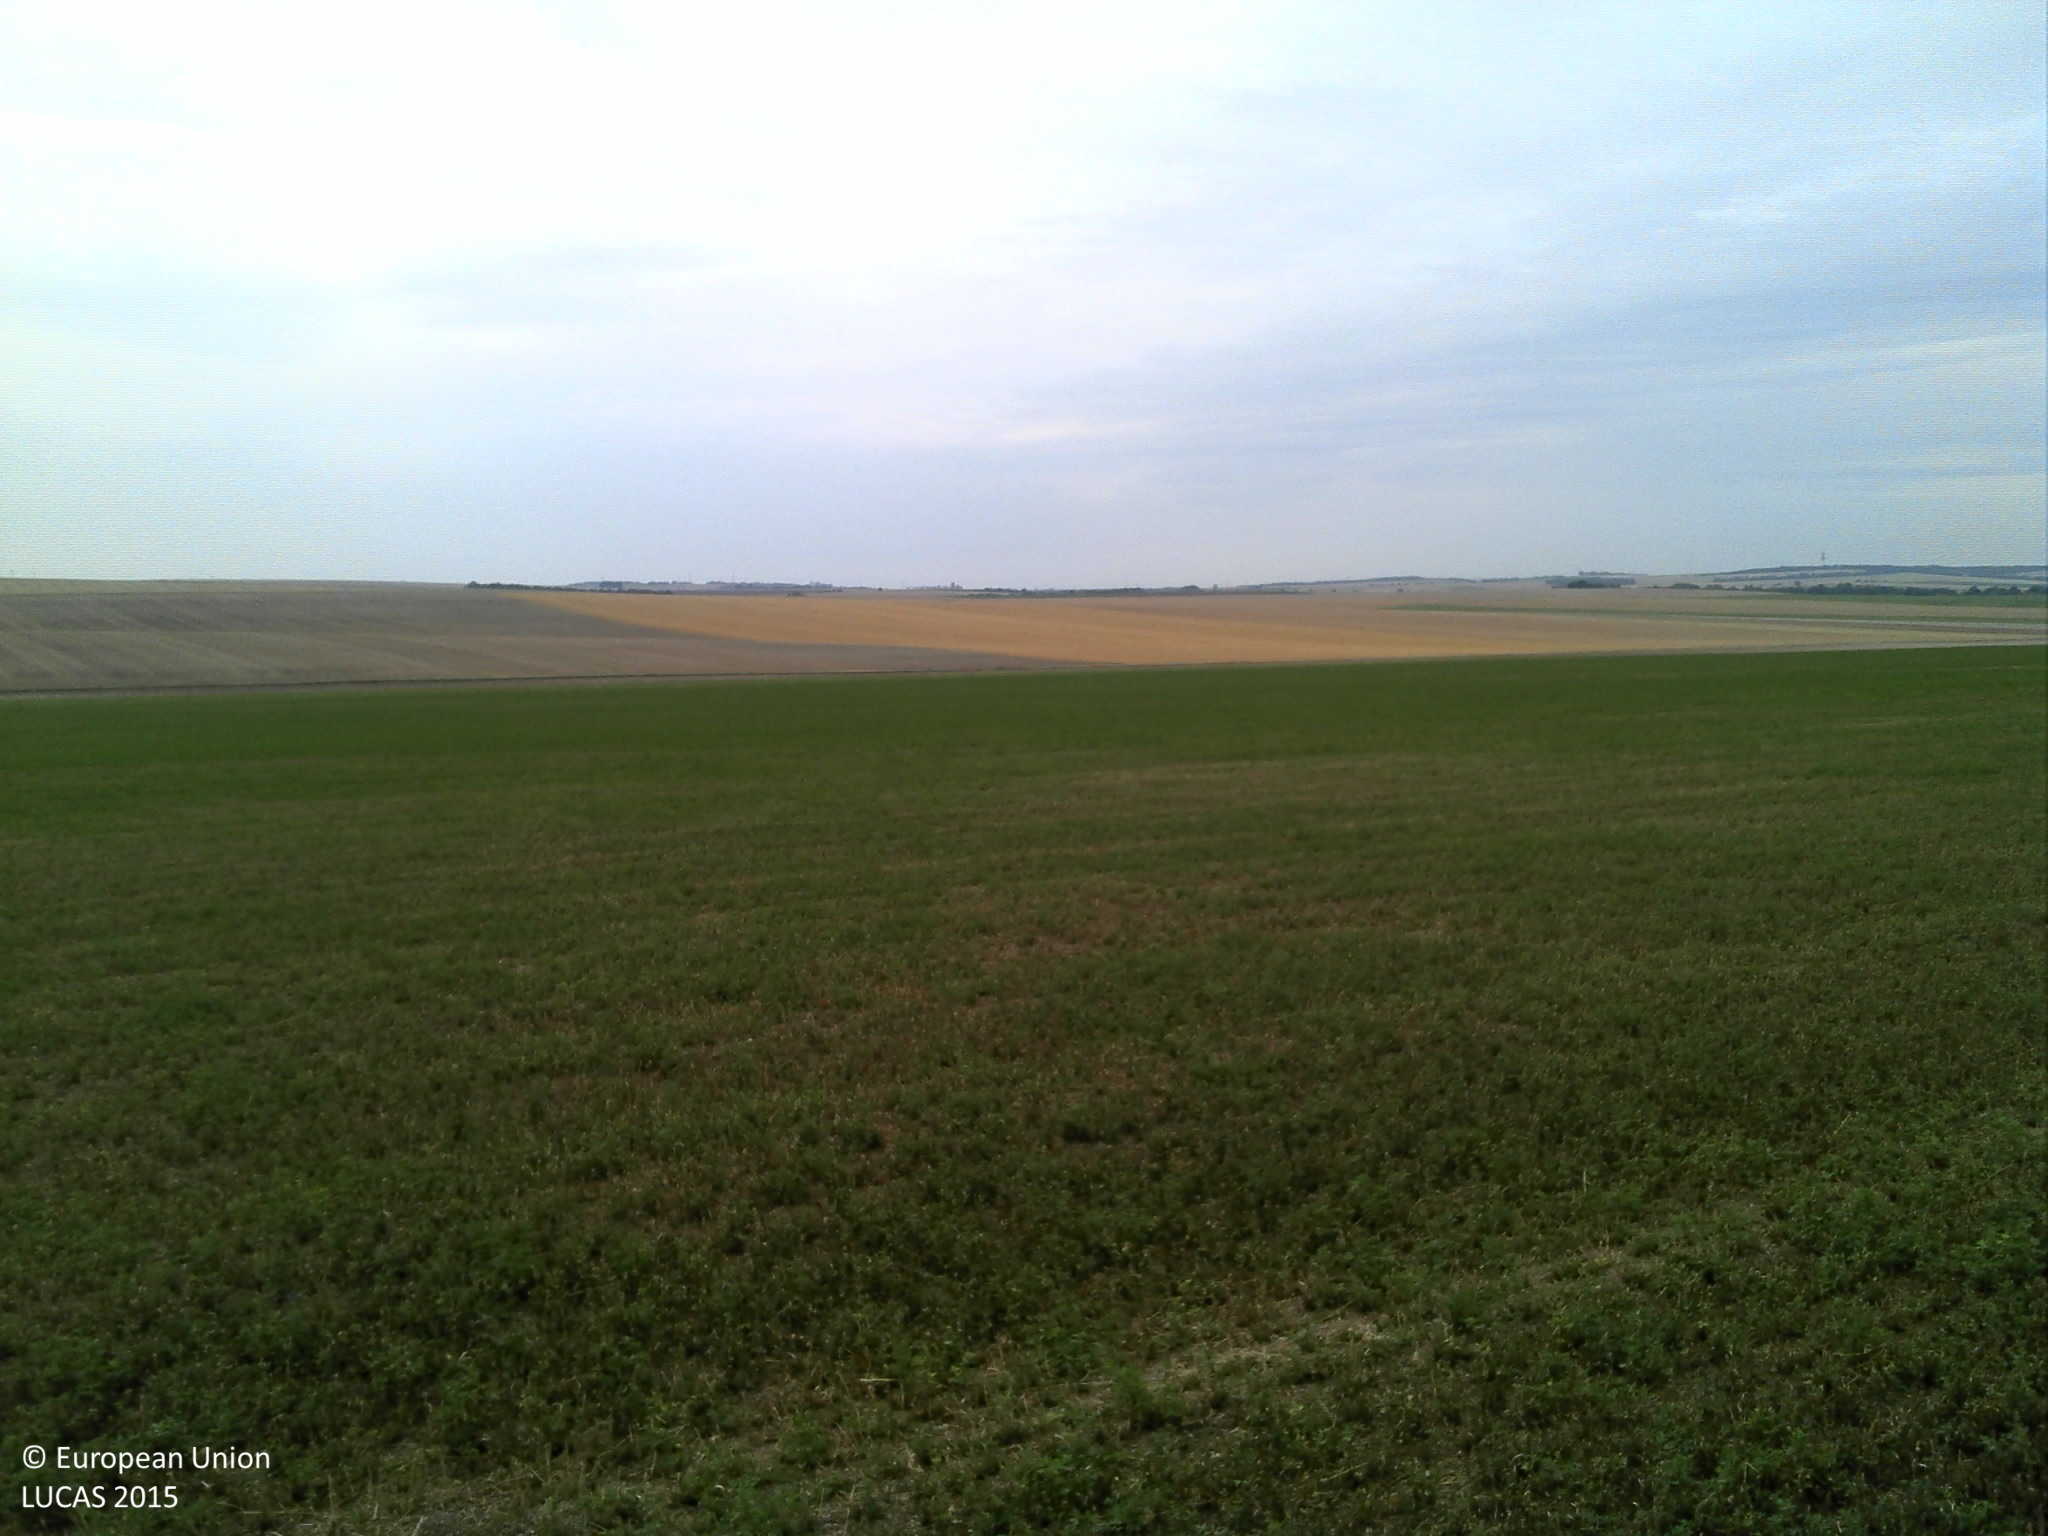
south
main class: Cropland
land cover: Lucerne
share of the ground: > 75 %
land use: Agriculture (excluding fallow land and kitchen gardens)
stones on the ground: 10 - 25 %
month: August
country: FR
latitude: 48.4316
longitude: 4.1983
